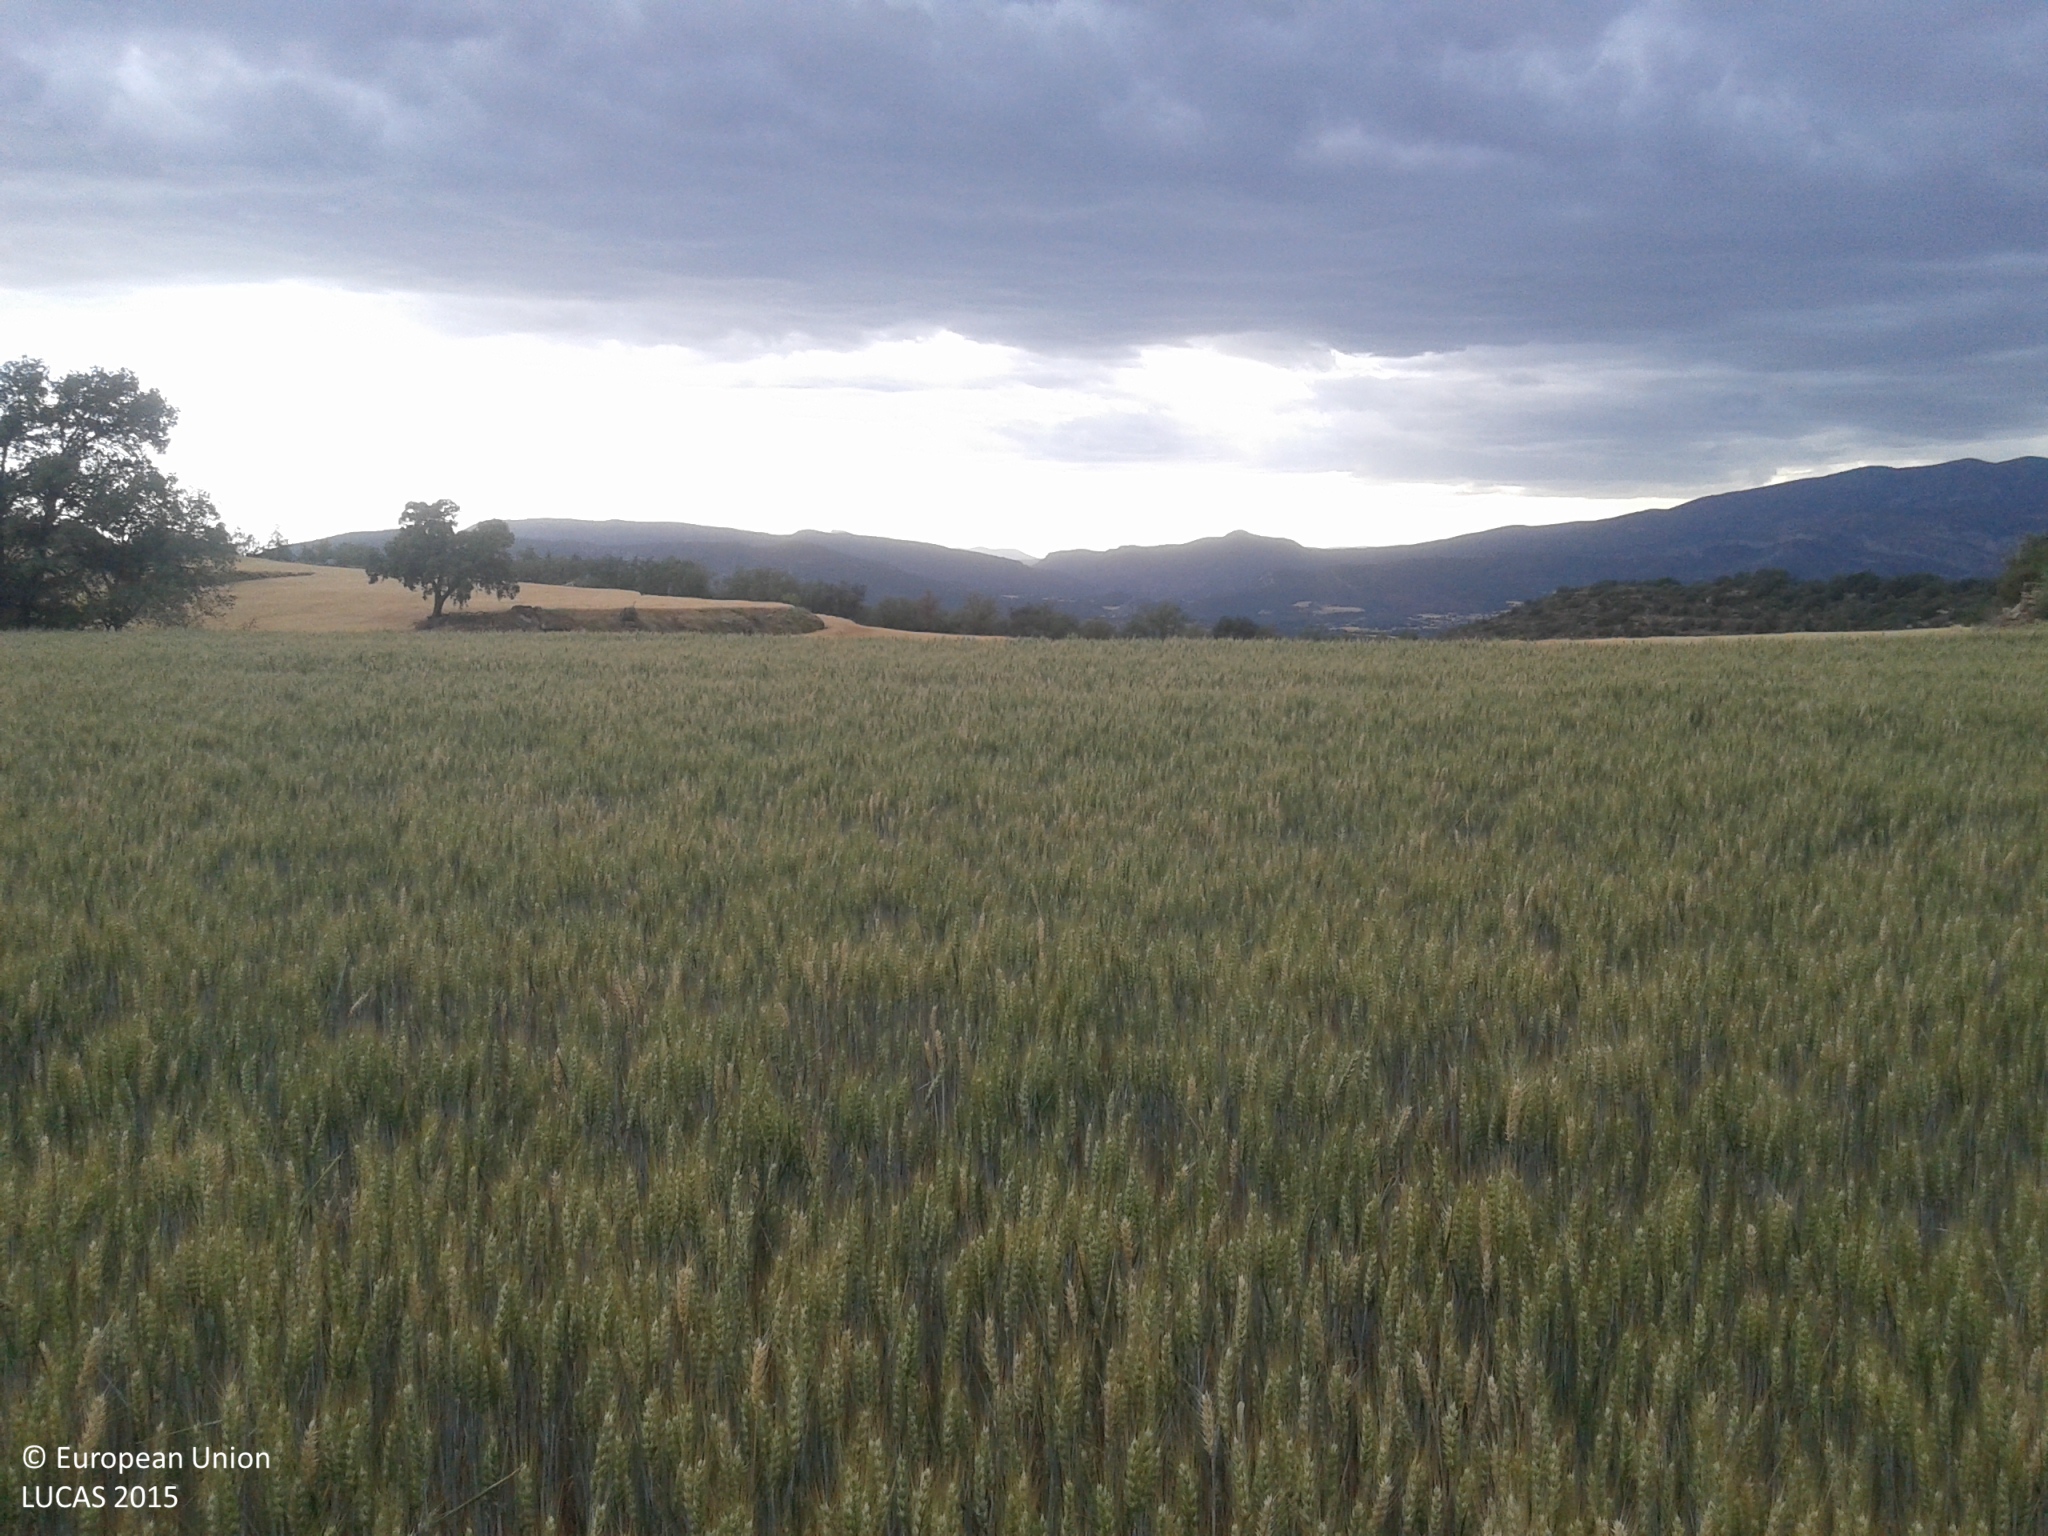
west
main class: Cropland
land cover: Common wheat
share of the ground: > 75 %
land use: Agriculture (excluding fallow land and kitchen gardens)
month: May
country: ES
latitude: 41.8965
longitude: 1.0801
